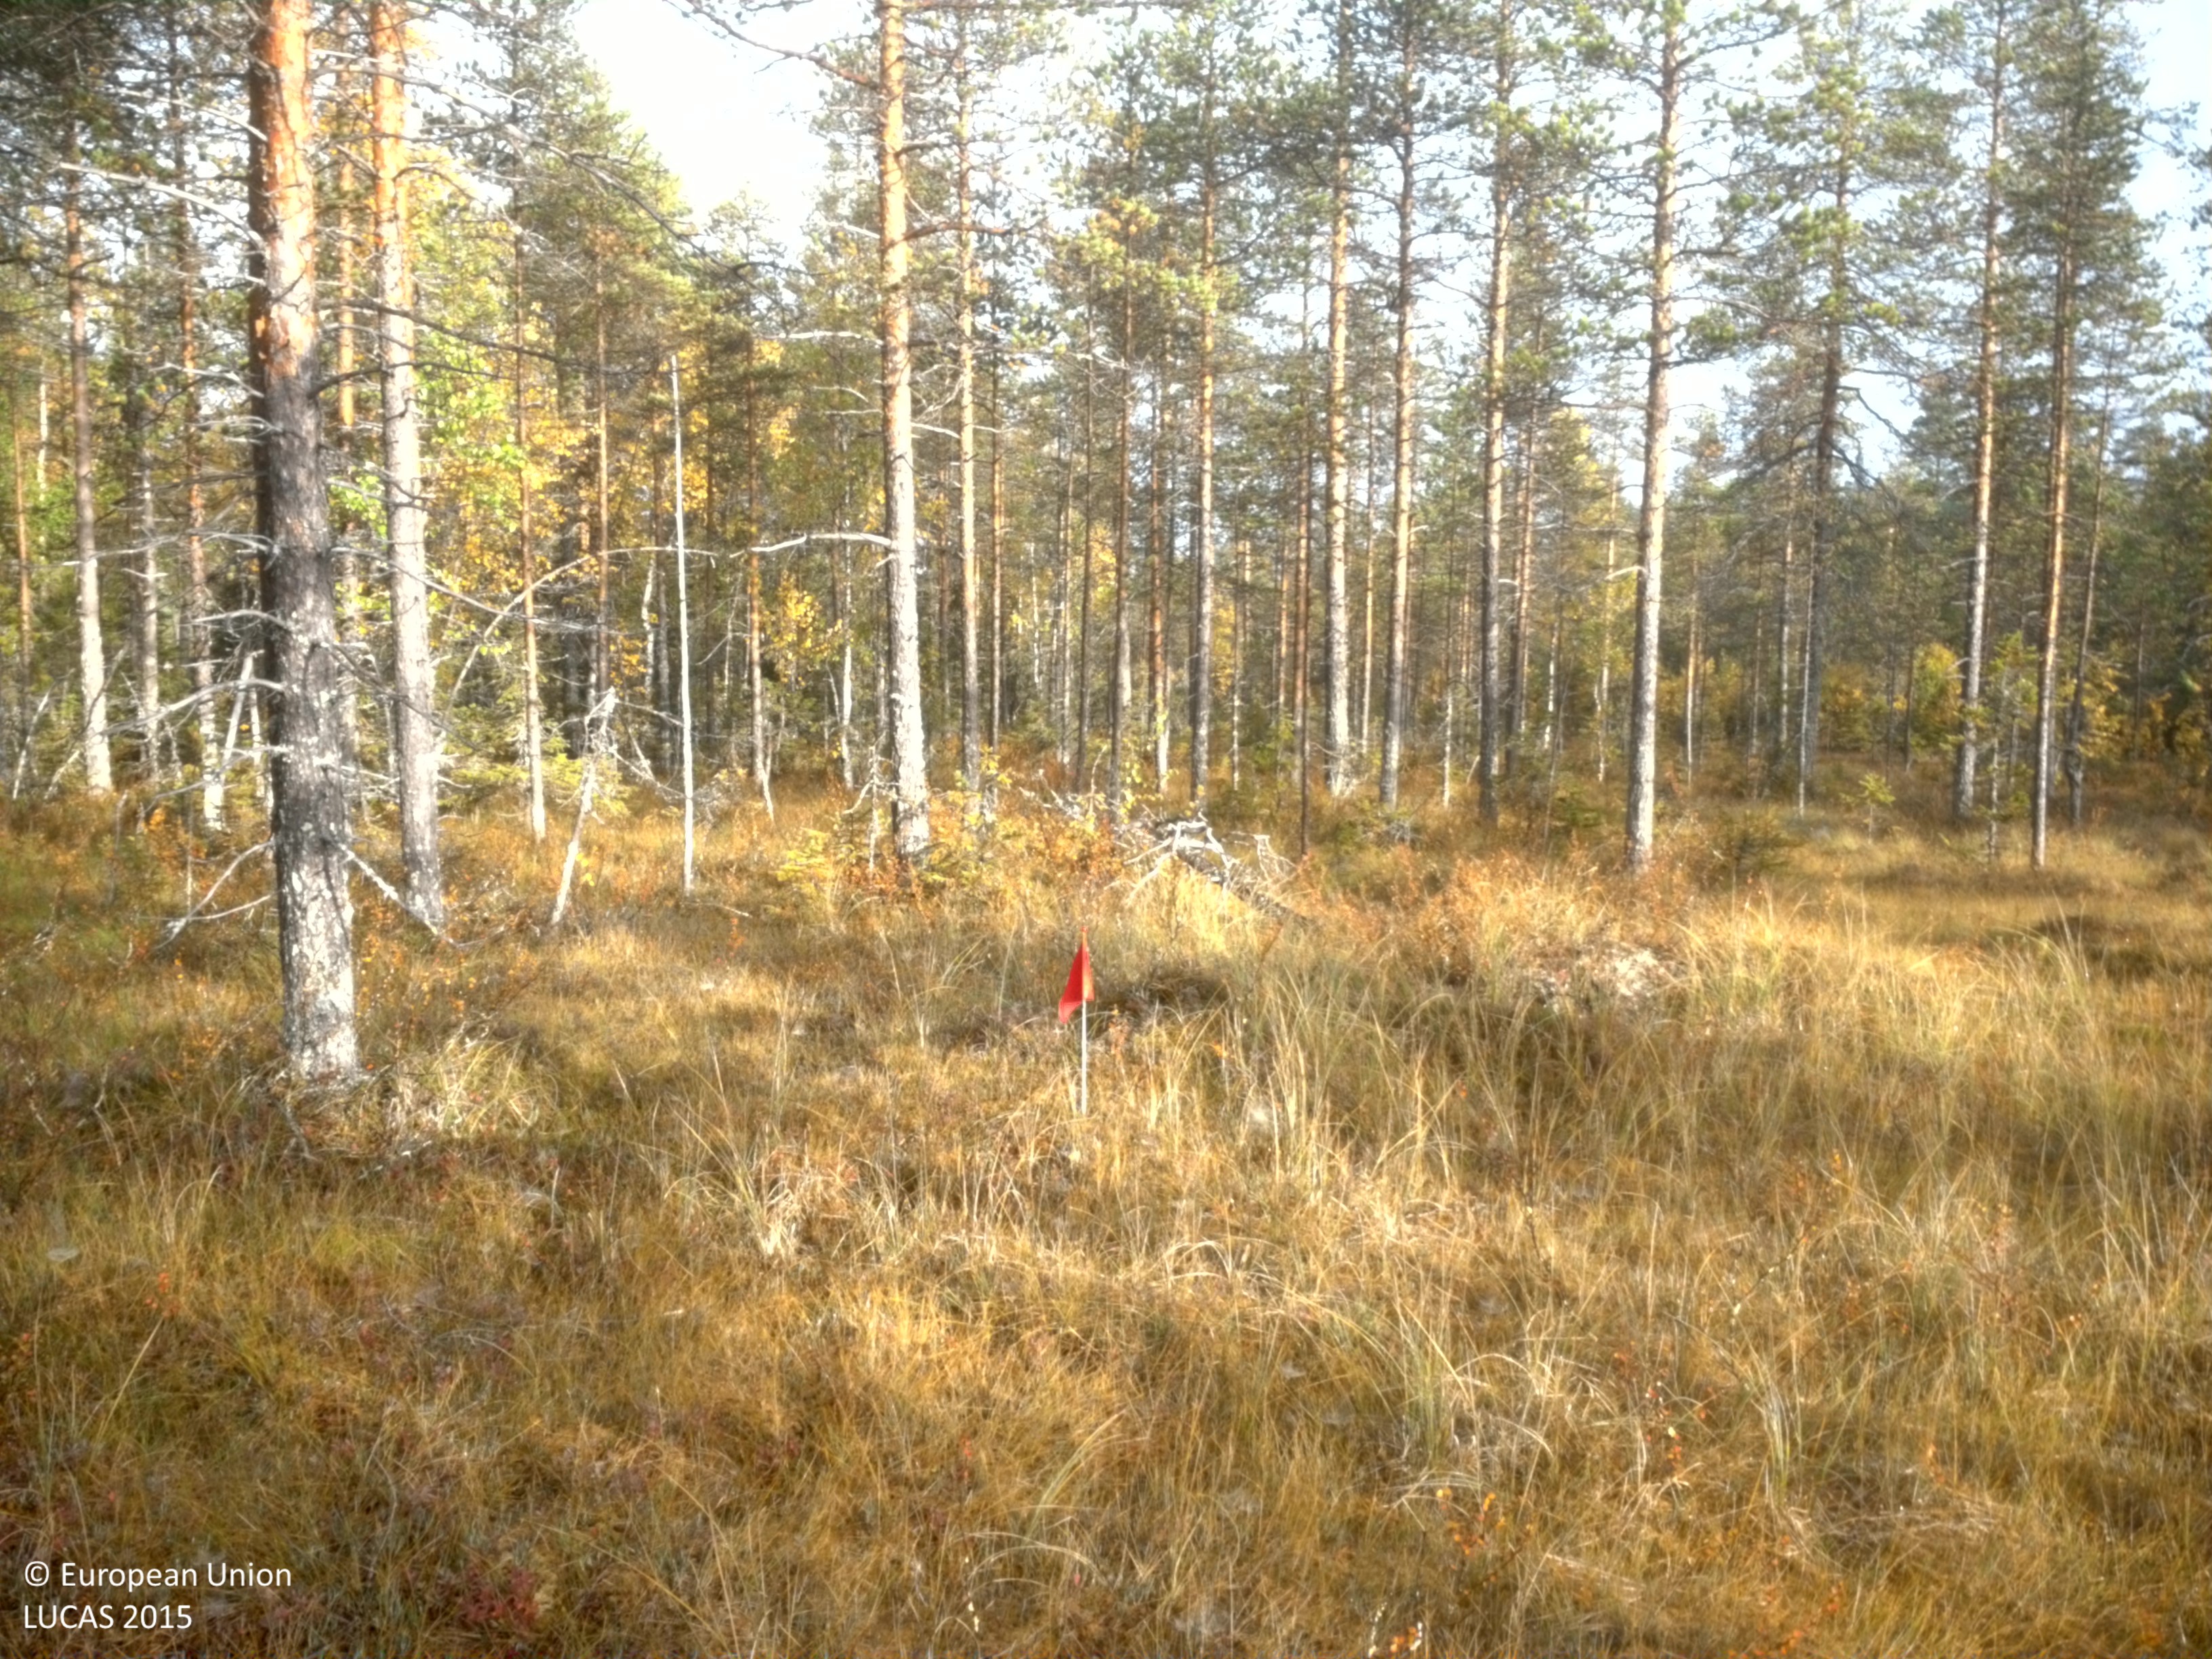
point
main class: Woodland
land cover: Pine dominated coniferous woodland
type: boreal forest
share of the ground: 25 - 50 %
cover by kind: lichens and mosses 40 %, coniferous forest trees 25 %, shrubs 20 %, herbaceous plants 10 %, broadleaved forest trees 5 %
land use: Amenities, museums, leisure
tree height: > 5 m
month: September
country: SE
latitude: 64.3768
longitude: 20.2356
